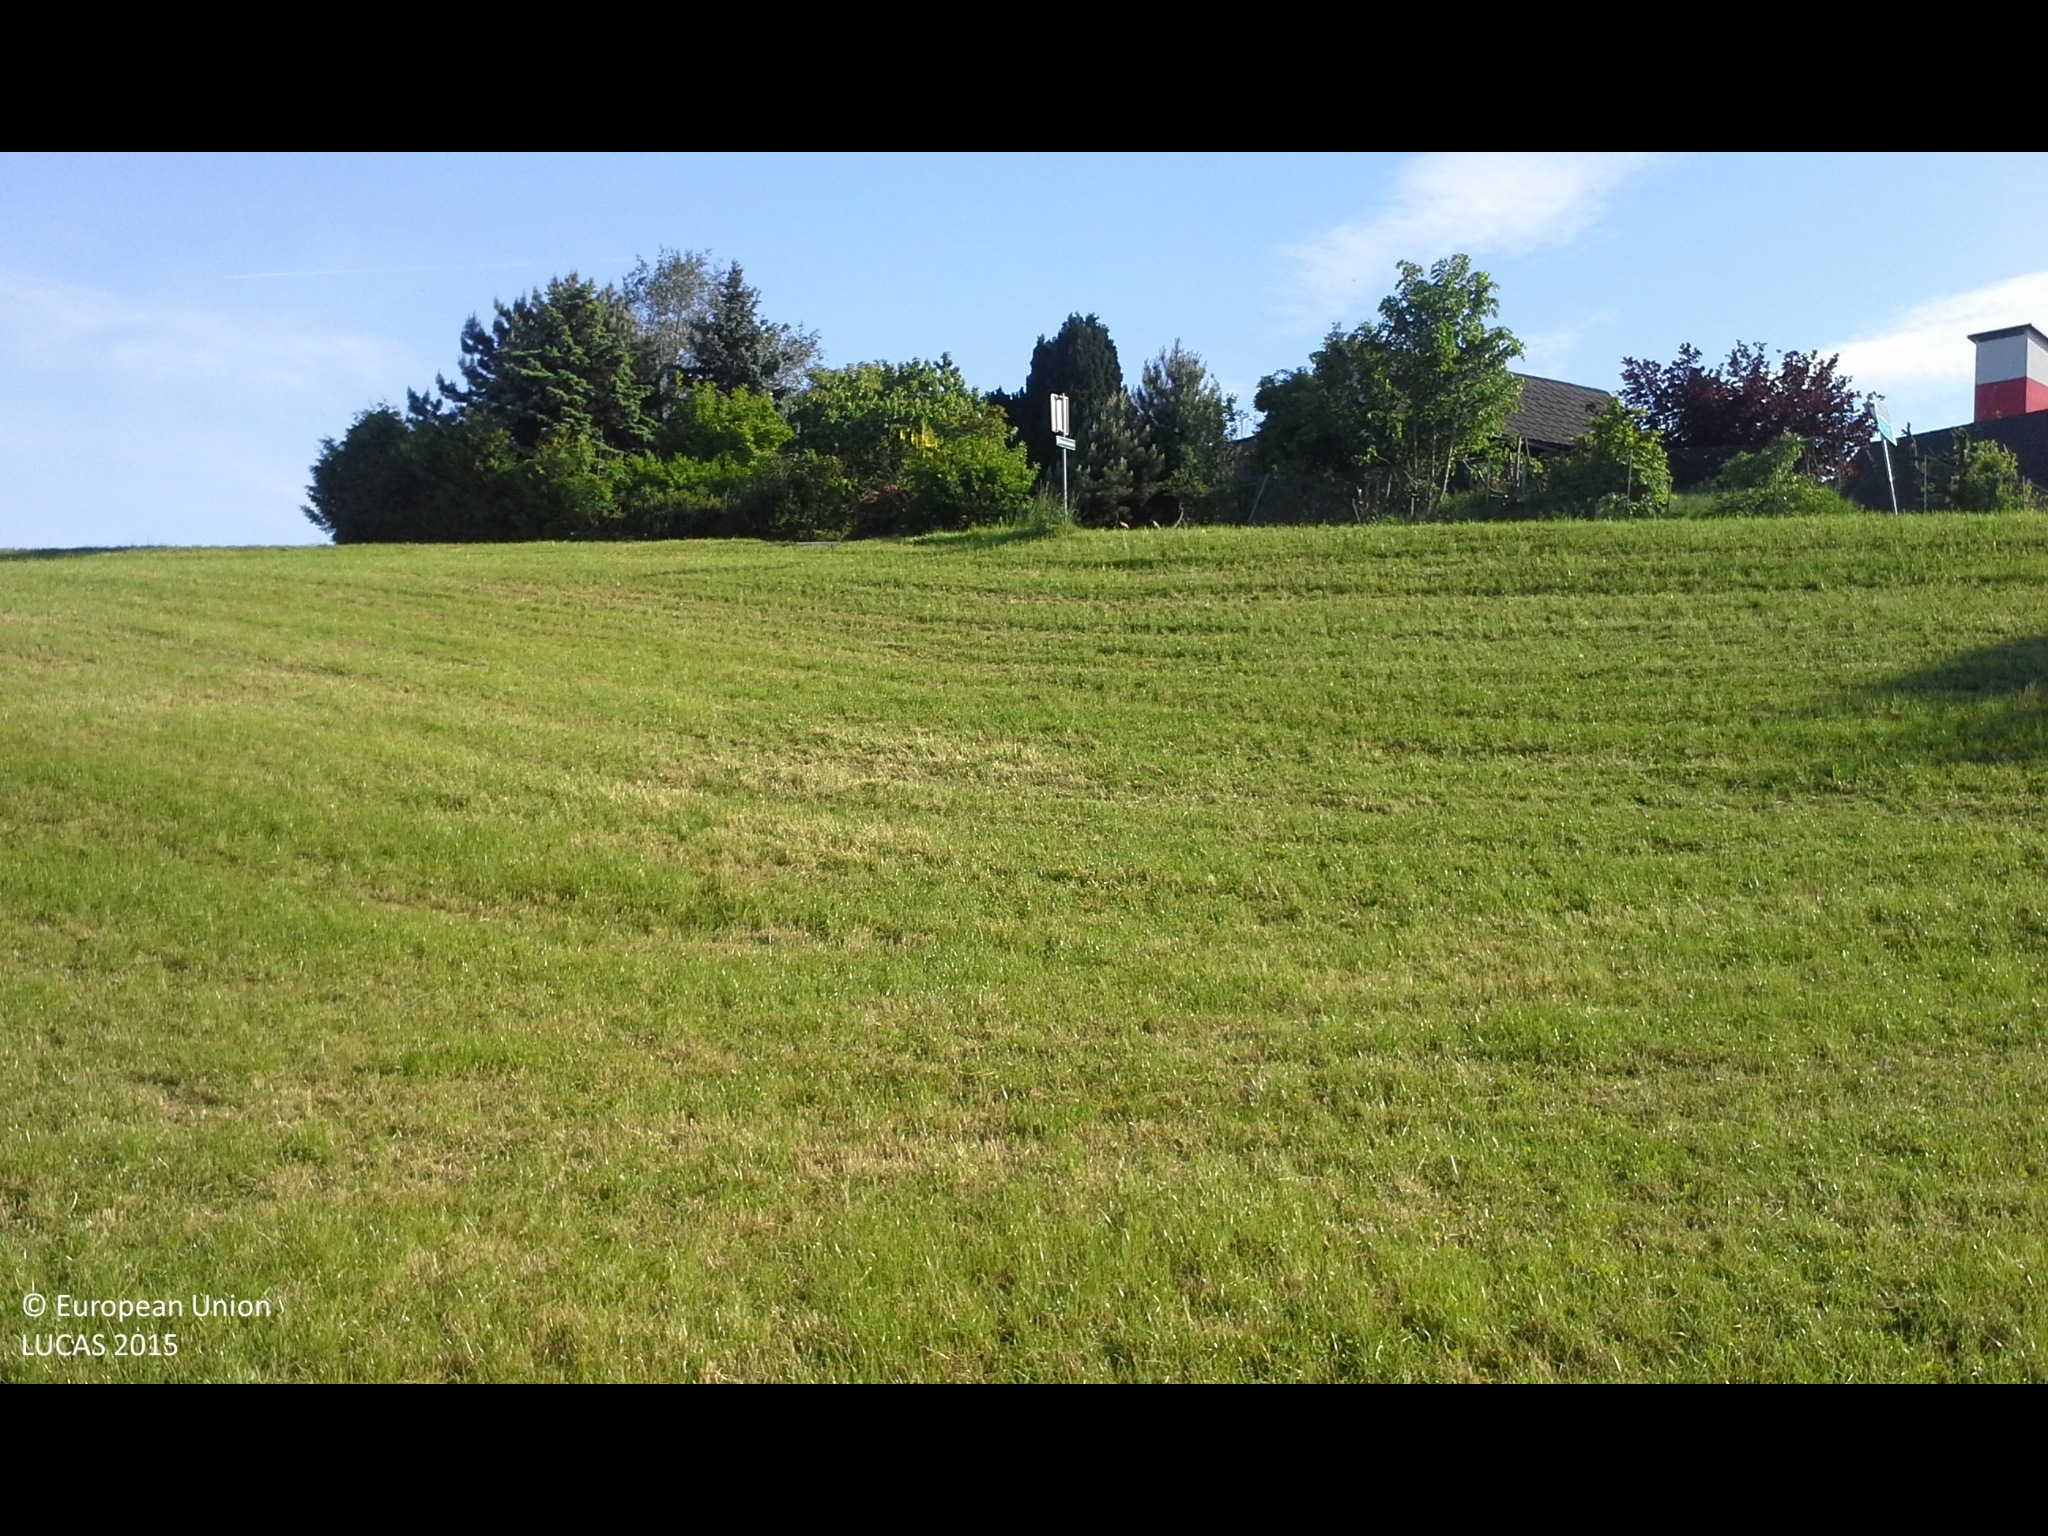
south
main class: Grassland
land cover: Grassland without tree/shrub cover
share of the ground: > 75 %
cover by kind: herbaceous plants 100 %
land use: Agriculture (excluding fallow land and kitchen gardens)
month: May
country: AT
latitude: 47.9796
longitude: 14.2466
